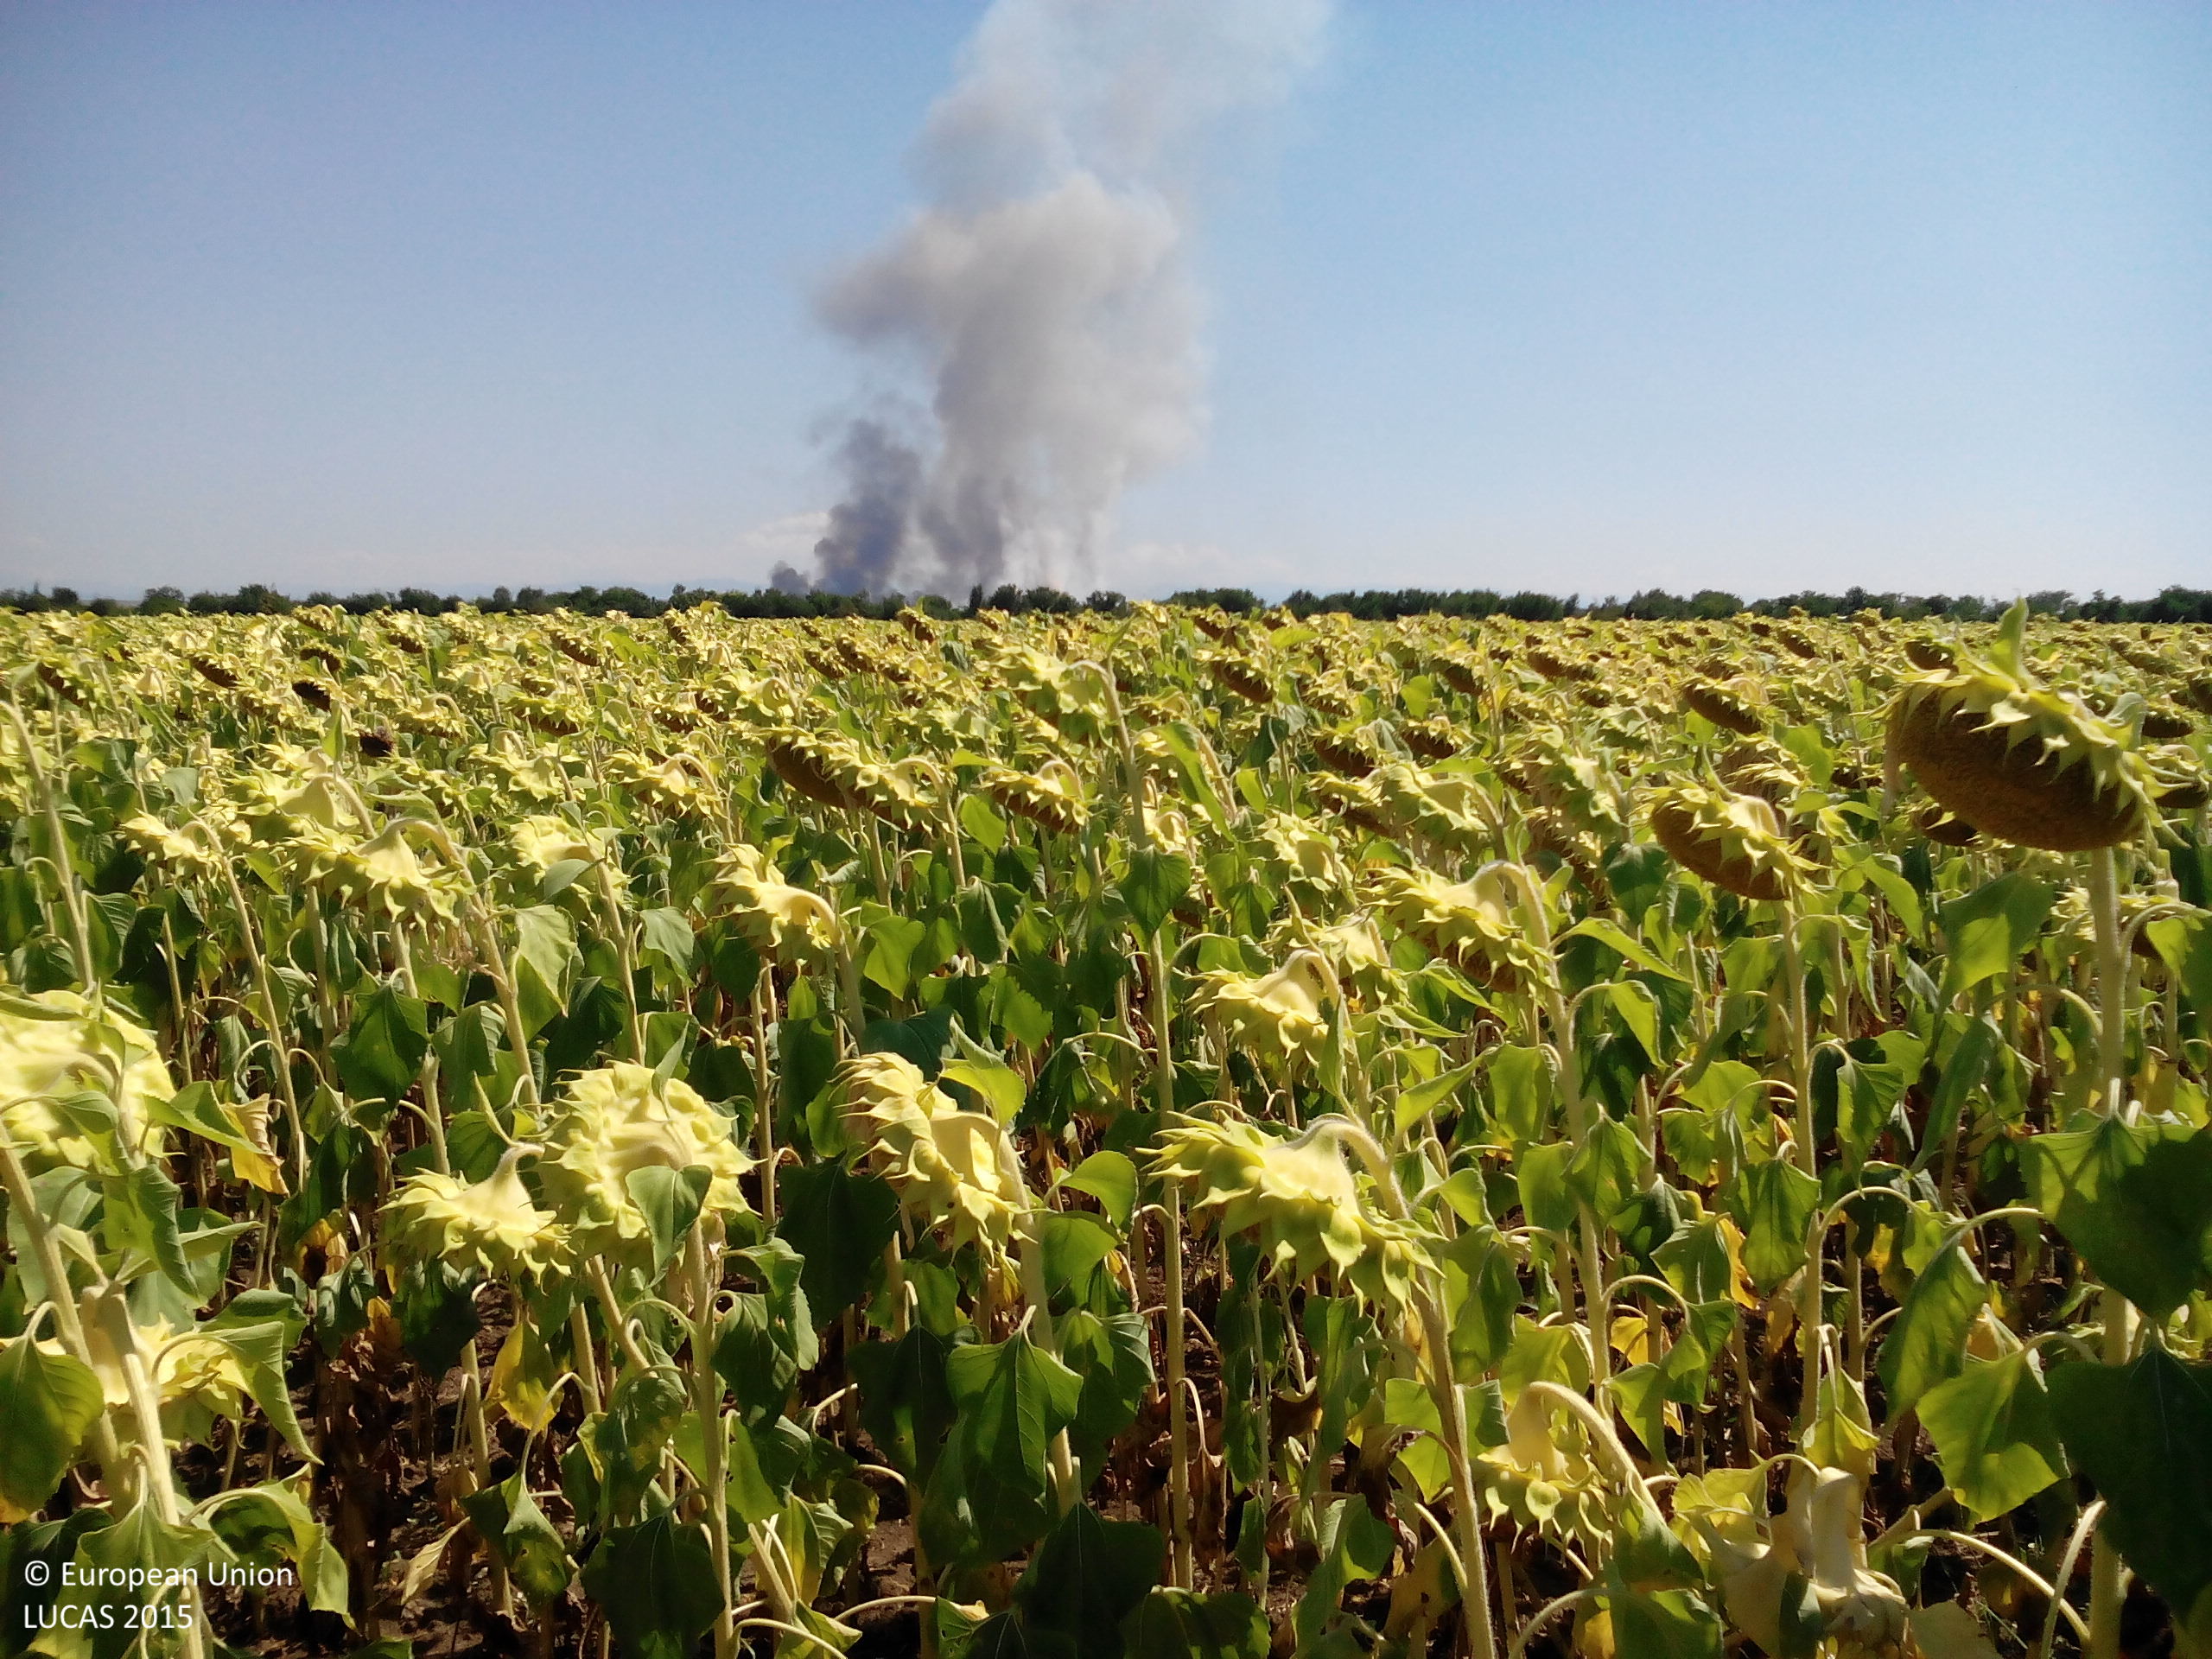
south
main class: Cropland
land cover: Sunflower
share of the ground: > 75 %
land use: Agriculture (excluding fallow land and kitchen gardens)
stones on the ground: < 10 %
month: July
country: BG
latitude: 43.3145
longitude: 24.3221
